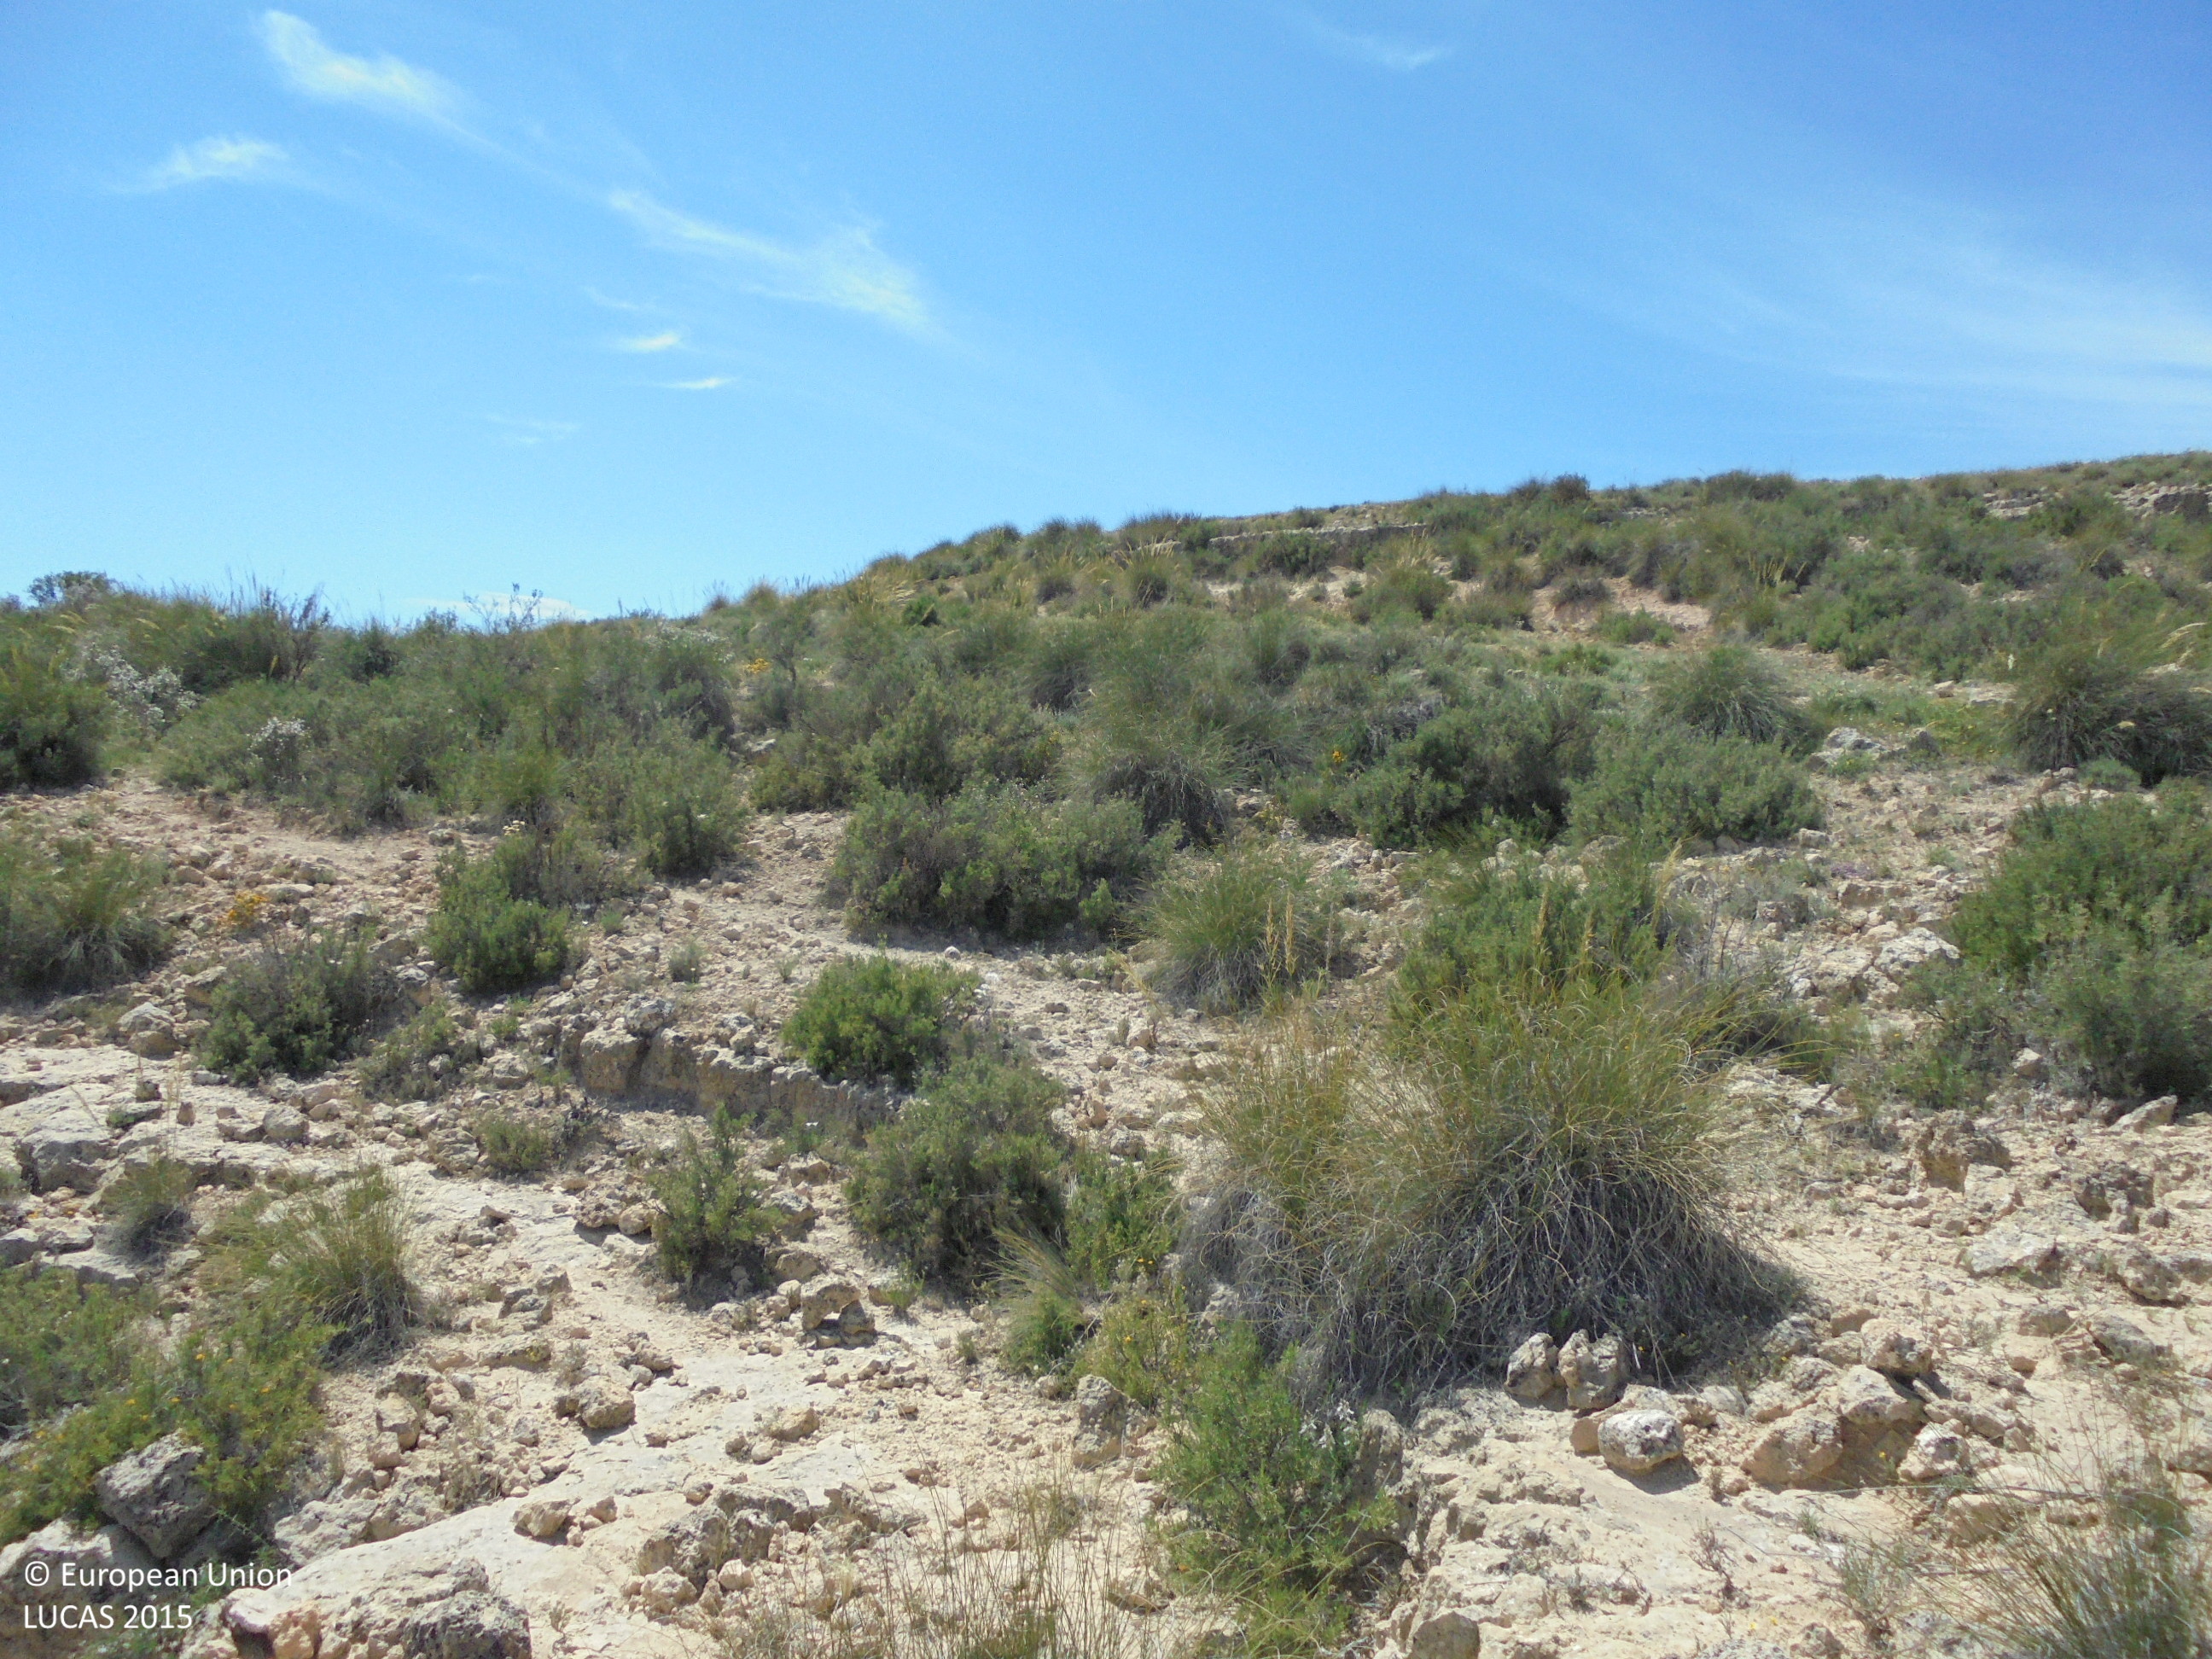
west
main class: Shrubland
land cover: Shrubland without tree cover
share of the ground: 50 - 75 %
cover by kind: shrubs 50 %, consolidated bare surface 35 %, herbaceous plants 15 %
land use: Semi-natural and natural areas not in use
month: May
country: ES
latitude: 39.1530
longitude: -1.6303
